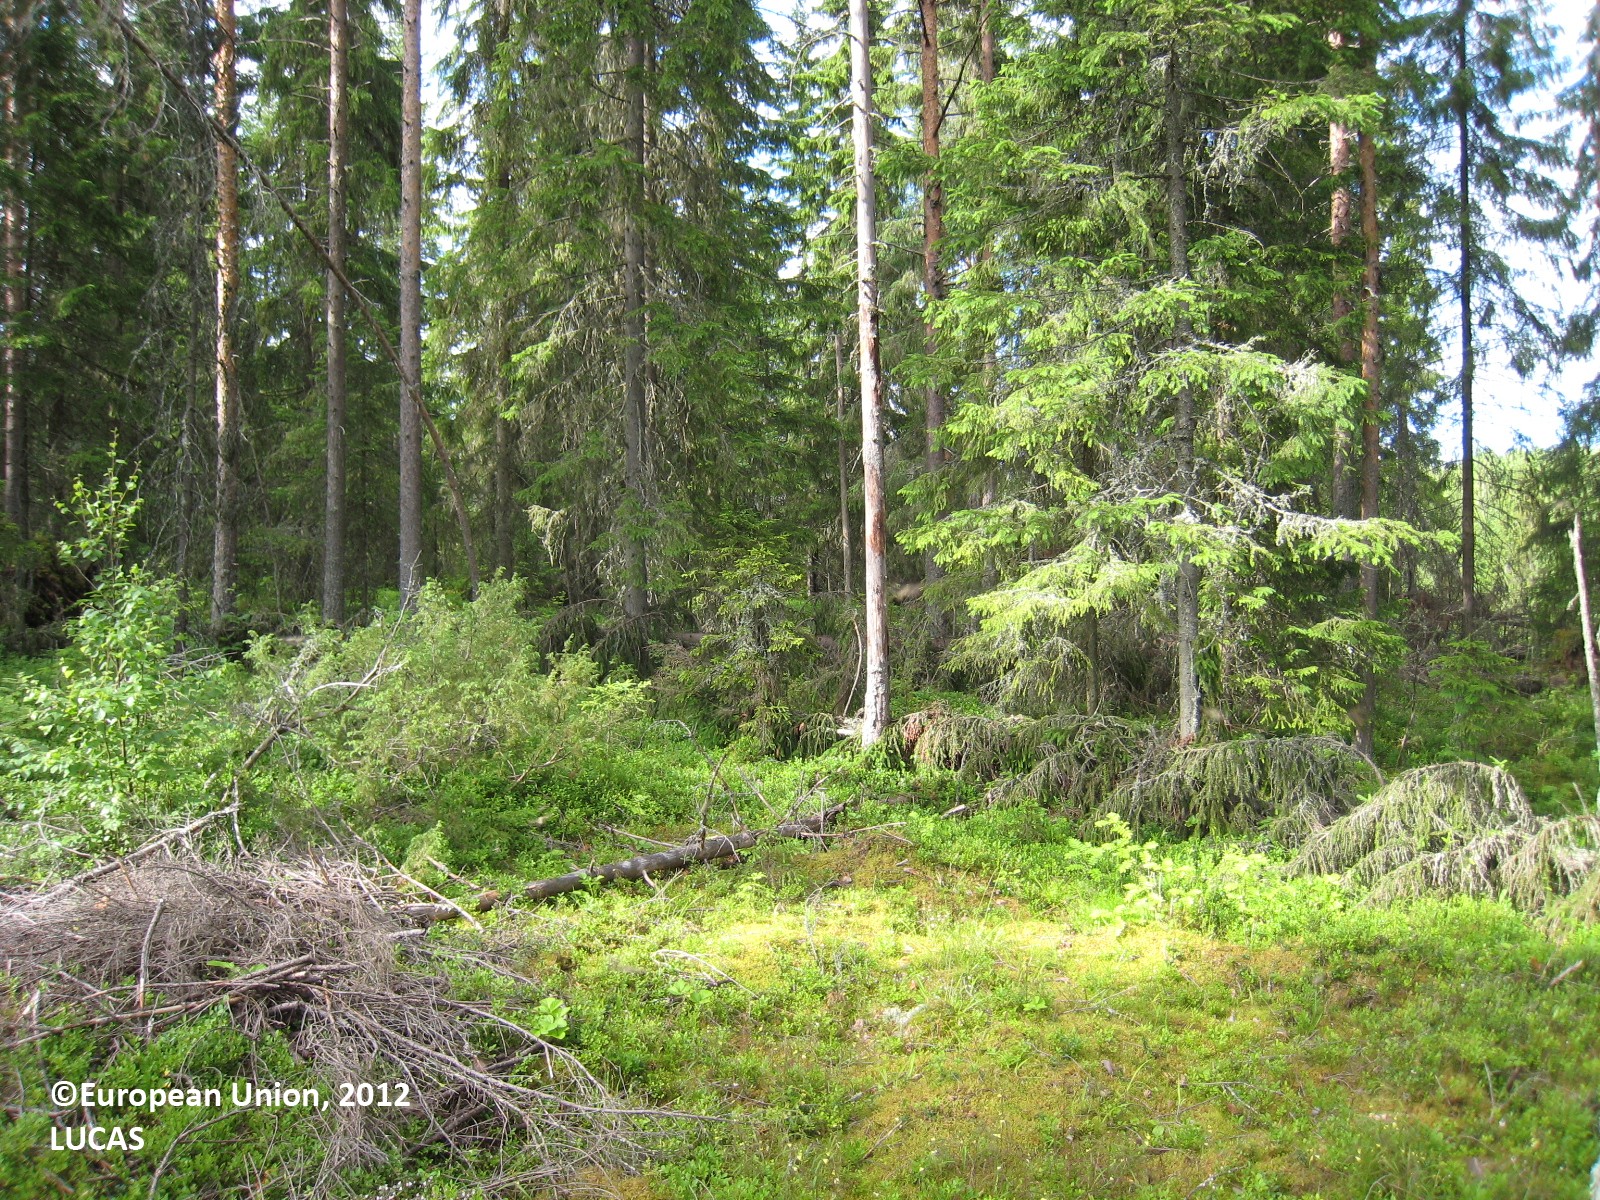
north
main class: Woodland
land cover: Other coniferous woodland
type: boreal forest
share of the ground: 50 - 75 %
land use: Forestry
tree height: > 5 m
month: July
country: FI
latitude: 62.9091
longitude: 25.6808
